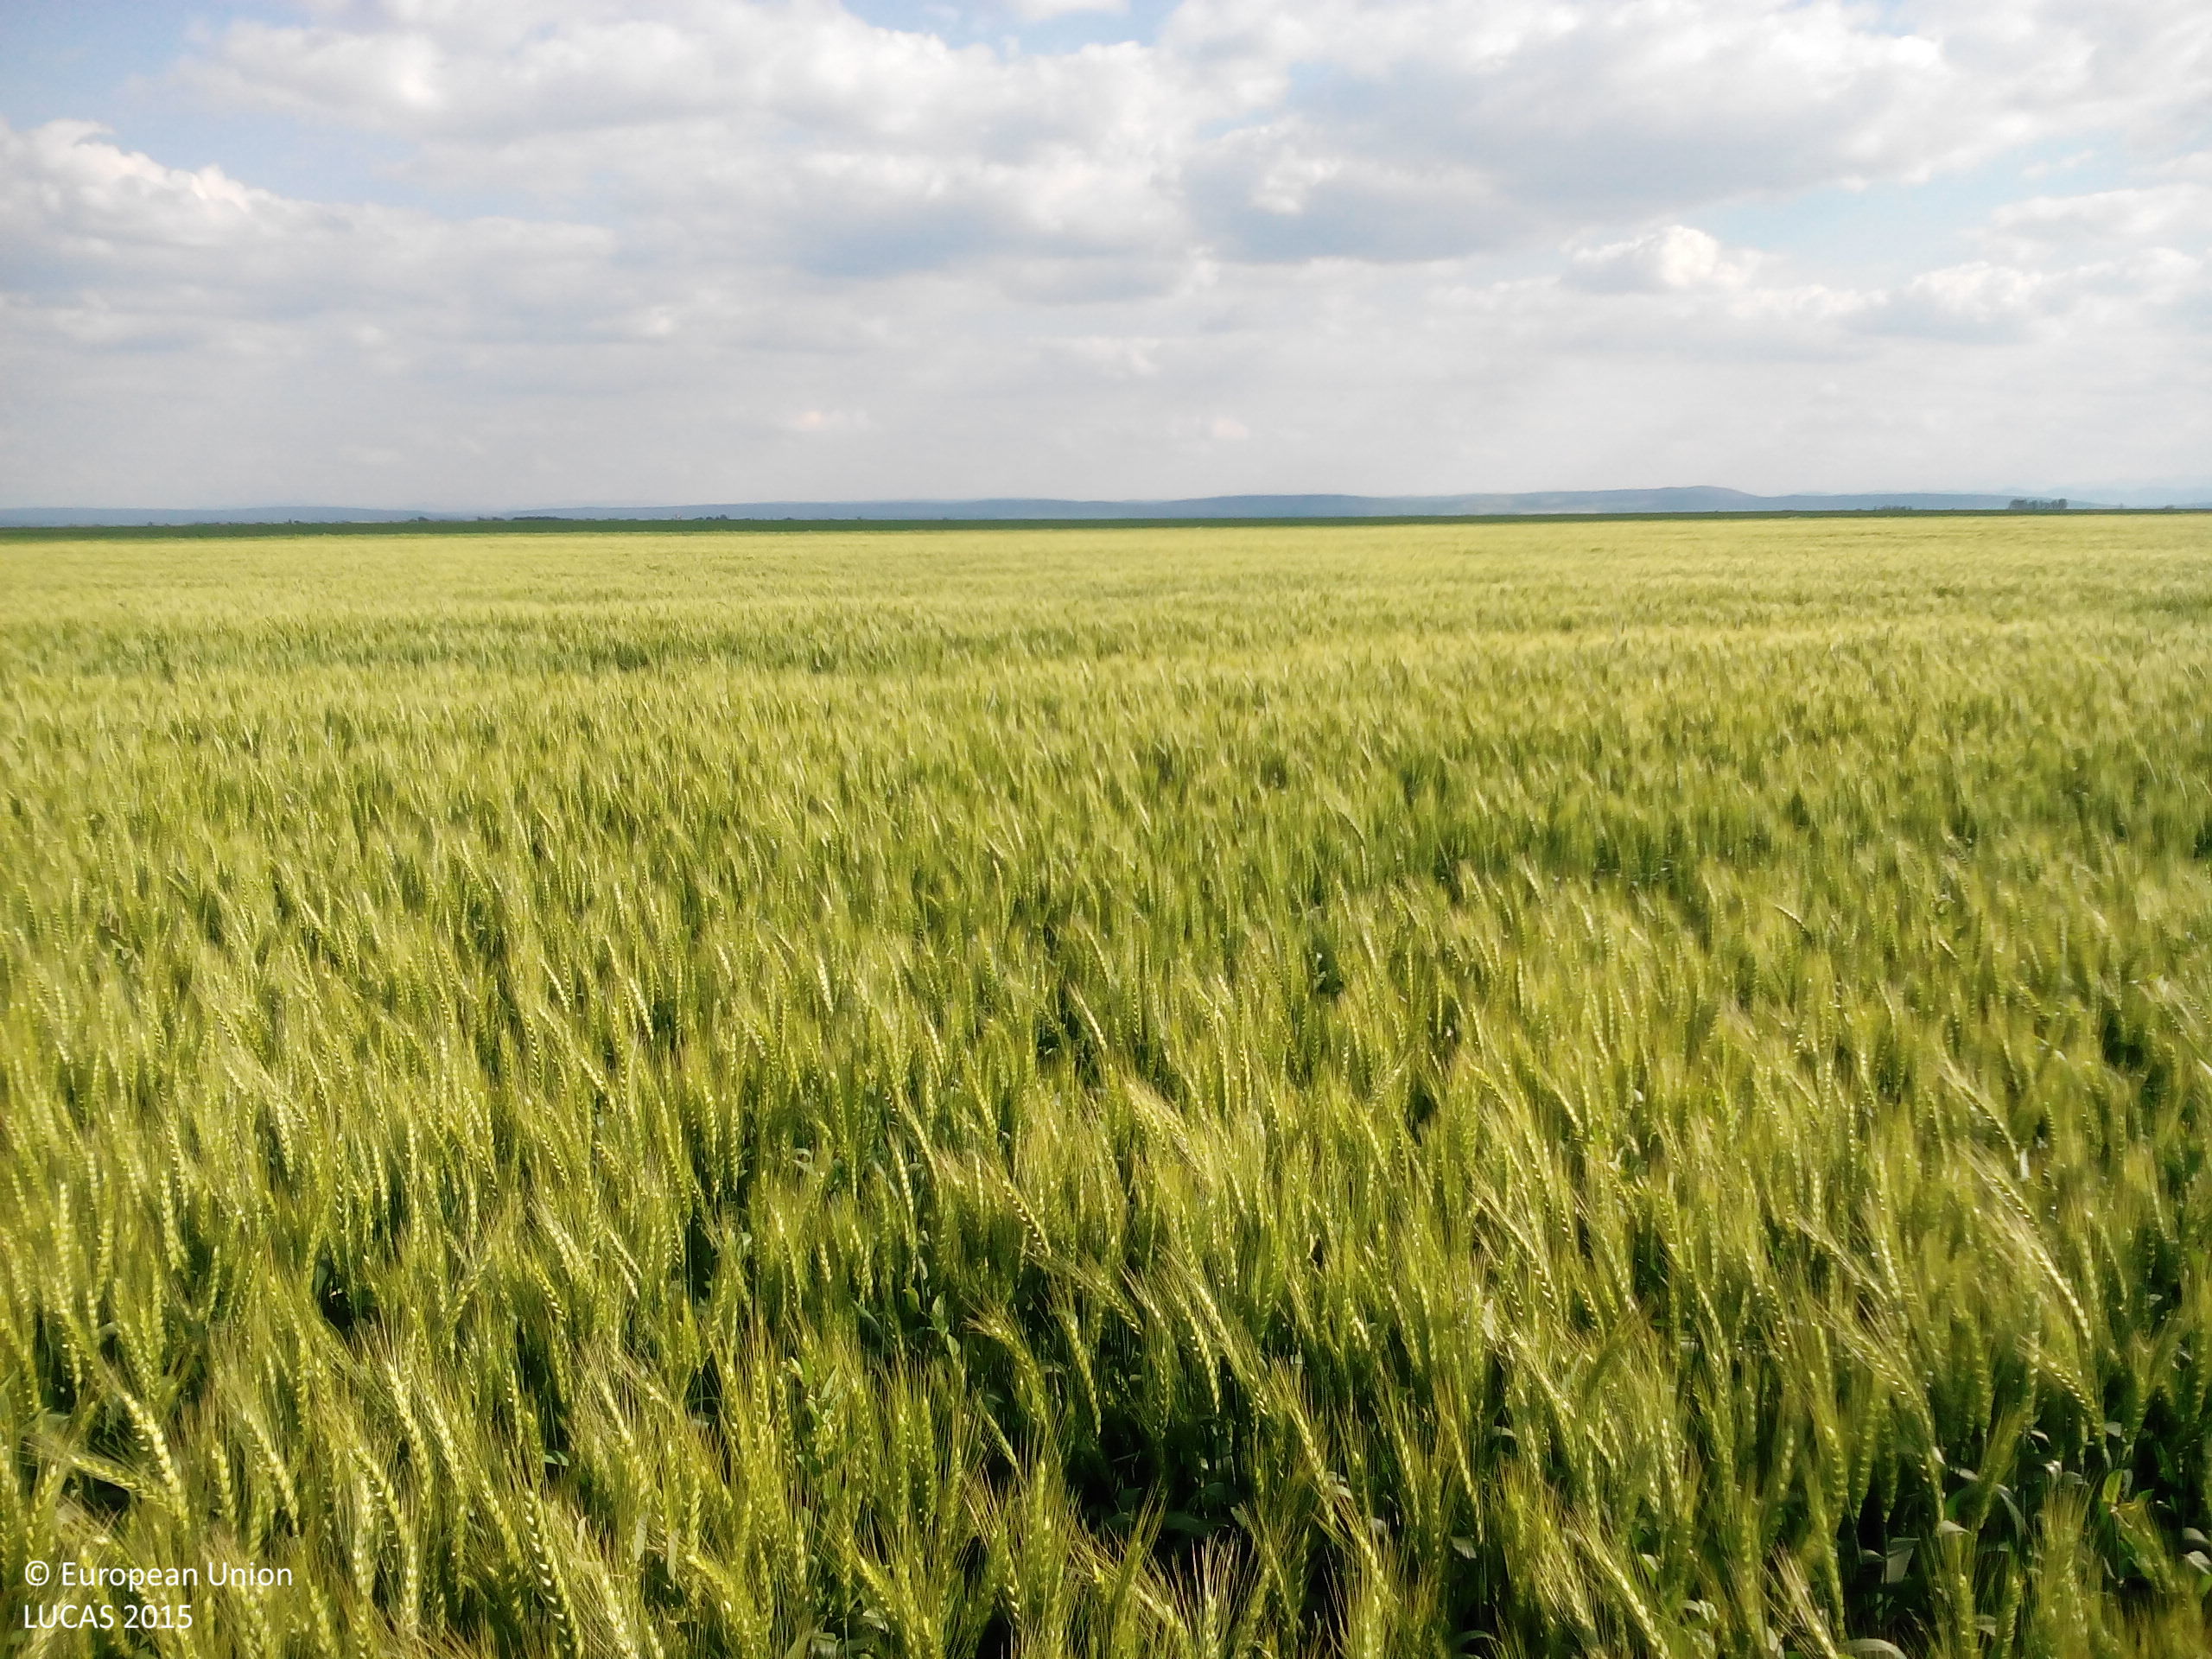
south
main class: Cropland
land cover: Common wheat
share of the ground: > 75 %
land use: Agriculture (excluding fallow land and kitchen gardens)
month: May
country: BG
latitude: 43.4704
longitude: 23.8578
